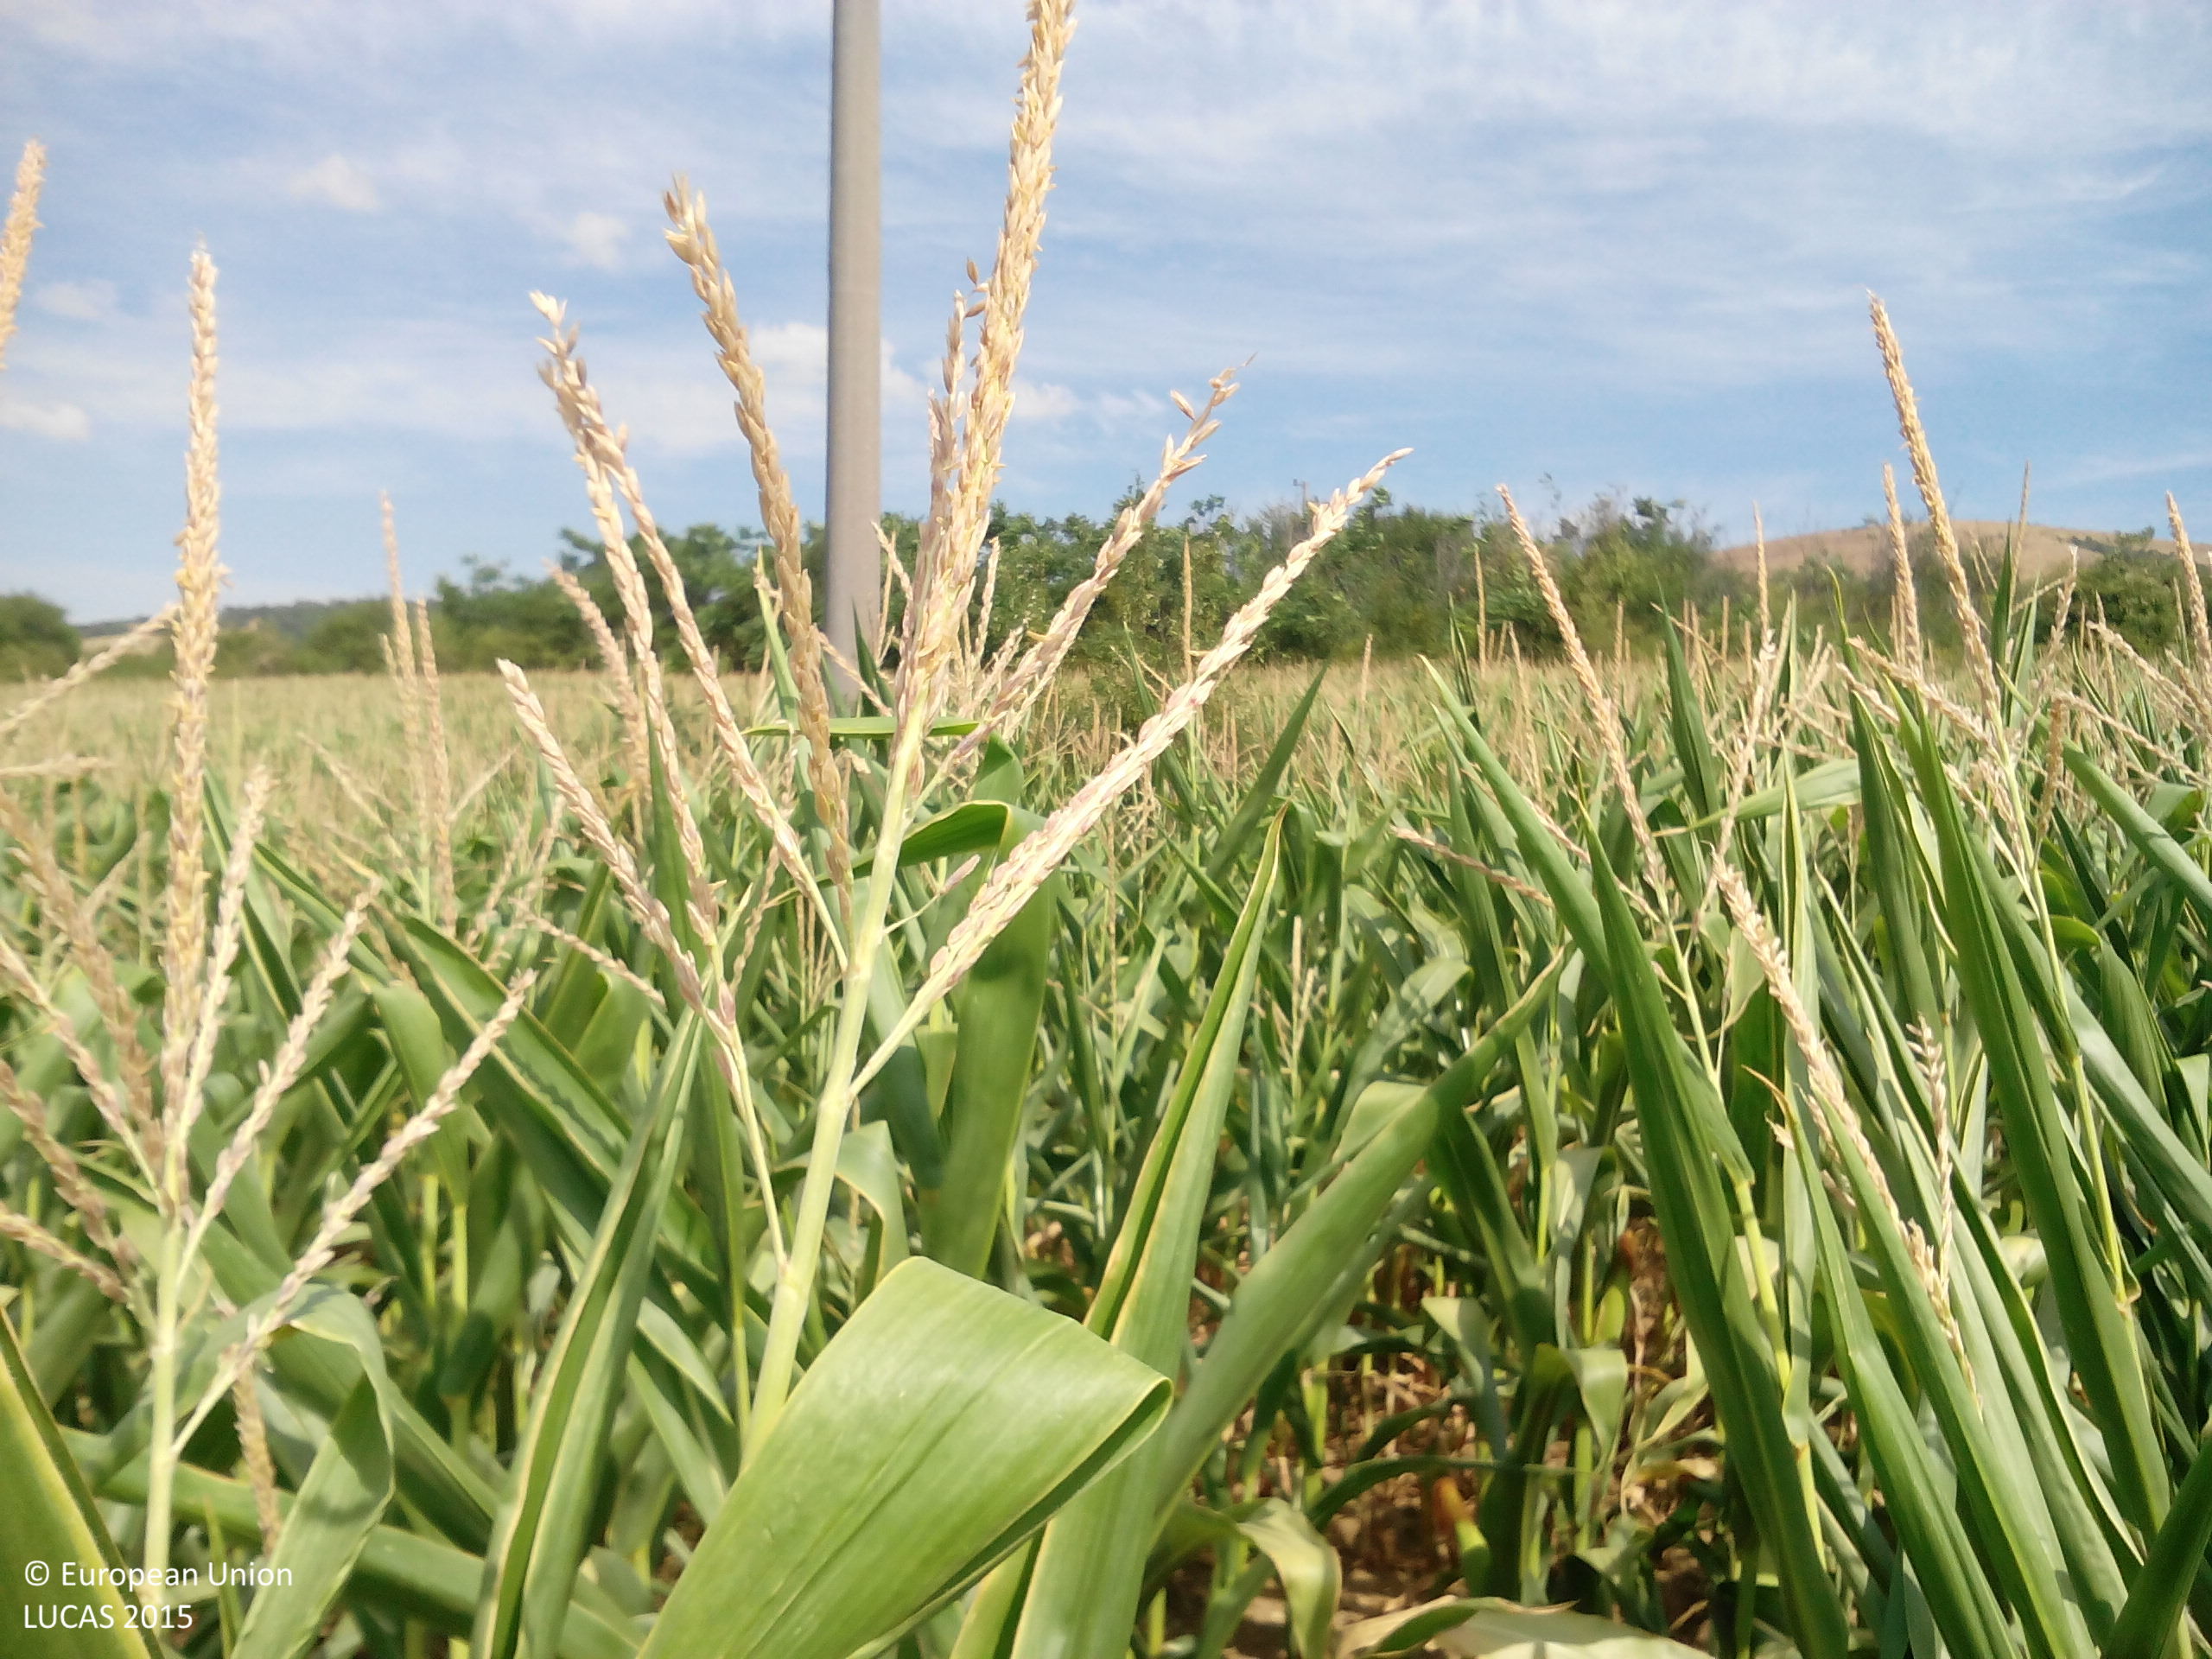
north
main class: Cropland
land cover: Maize
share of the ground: > 75 %
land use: Agriculture (excluding fallow land and kitchen gardens)
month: August
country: BG
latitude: 43.1871
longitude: 23.7900
